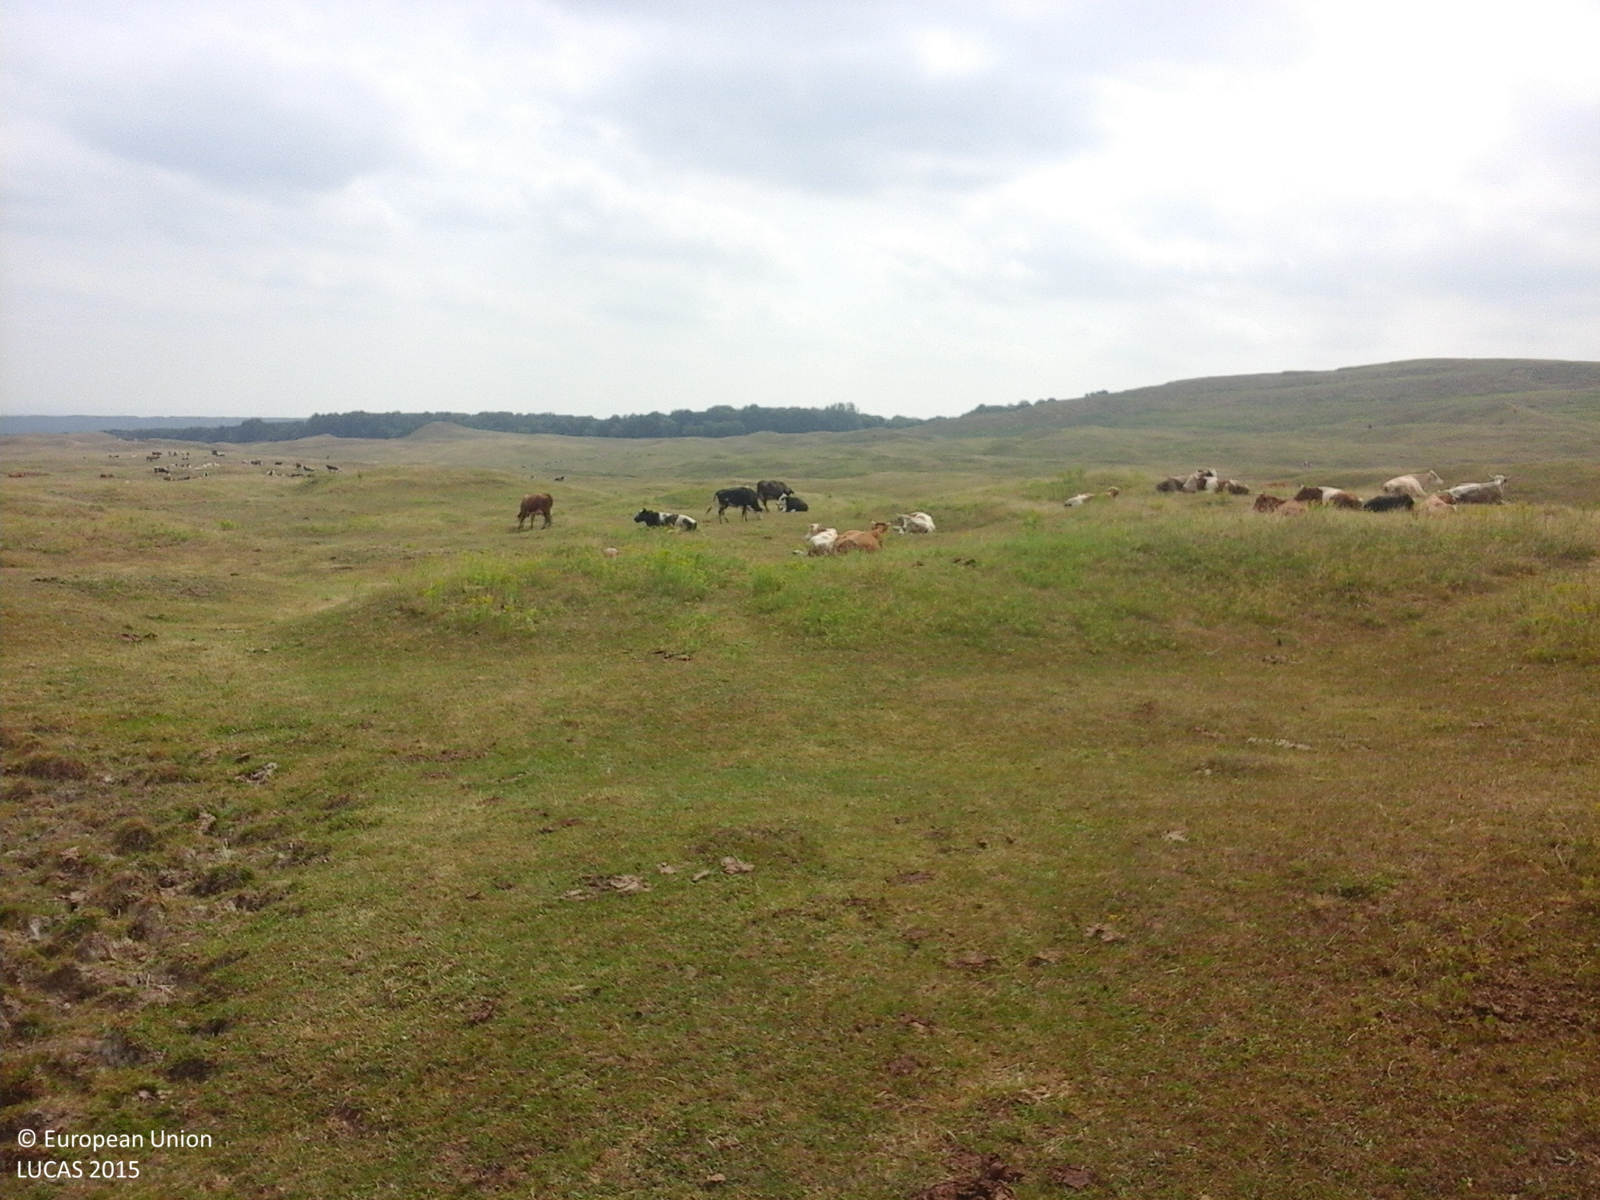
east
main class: Grassland
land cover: Grassland without tree/shrub cover
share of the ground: > 75 %
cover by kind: herbaceous plants 100 %
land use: Agriculture (excluding fallow land and kitchen gardens)
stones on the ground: < 10 %
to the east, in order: Grassland without tree/shrub cover; Tracks; Grassland without tree/shrub cover
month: June
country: RO
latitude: 47.6316
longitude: 26.6085
